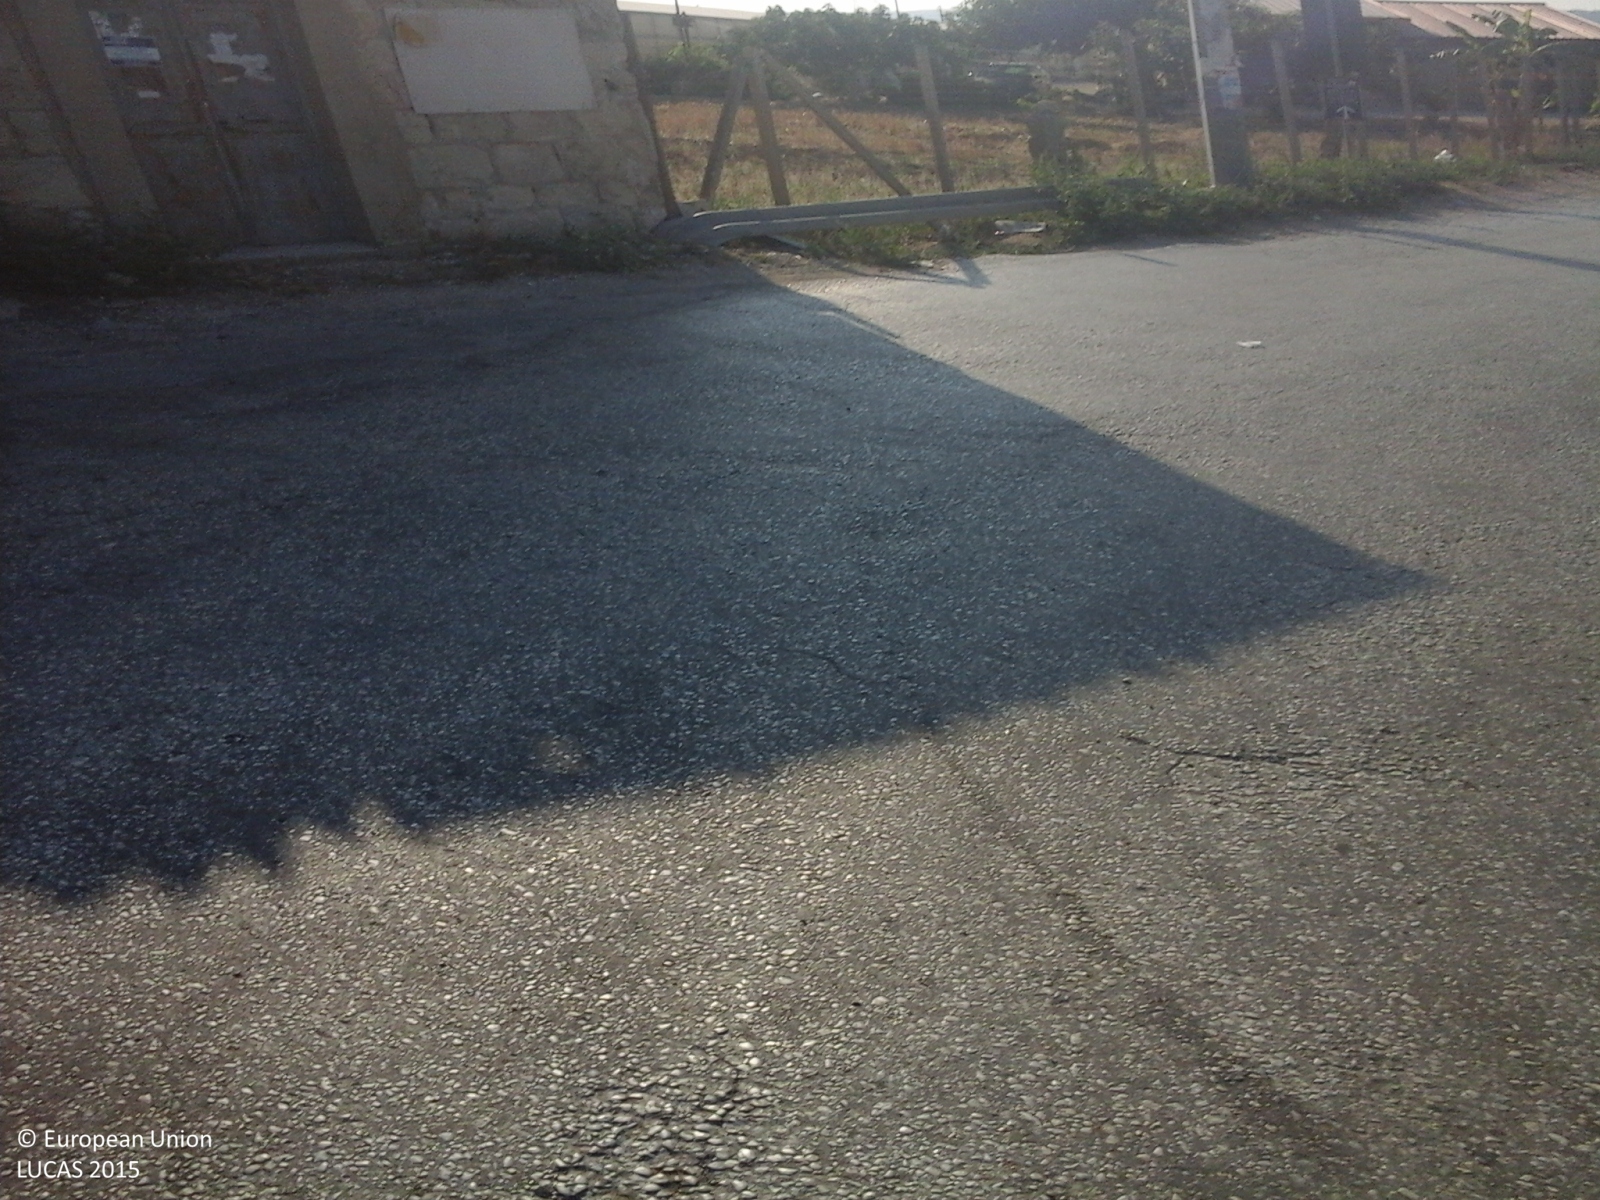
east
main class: Cropland
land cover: Durum wheat
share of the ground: > 75 %
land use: Agriculture (excluding fallow land and kitchen gardens)
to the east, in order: Durum wheat; Artificial constructions in urban areas; Olive groves; Artificial constructions in urban areas; Durum wheat; Artificial constructions in urban areas
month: July
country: IT
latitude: 37.0272
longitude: 14.4053
